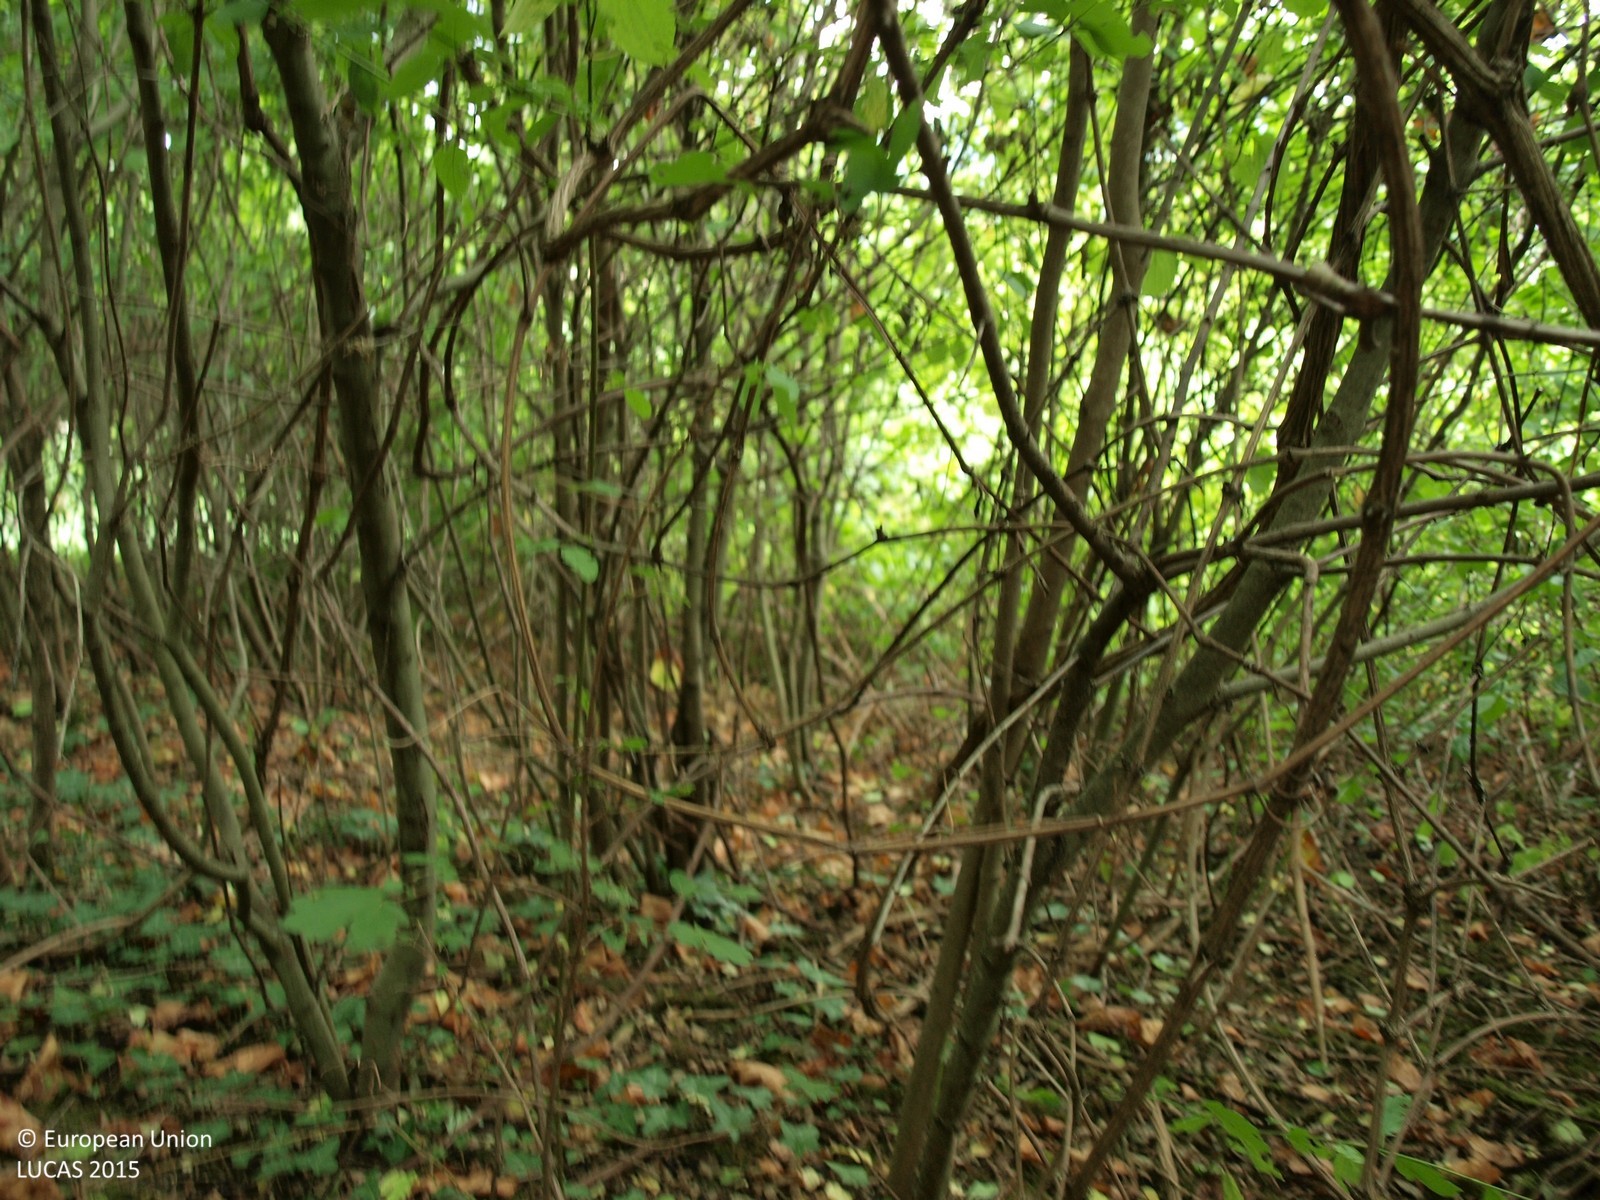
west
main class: Shrubland
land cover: Shrubland without tree cover
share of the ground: > 75 %
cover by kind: shrubs 100 %
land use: Semi-natural and natural areas not in use
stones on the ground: < 10 %
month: July
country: HR
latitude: 45.9243
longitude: 16.0977
